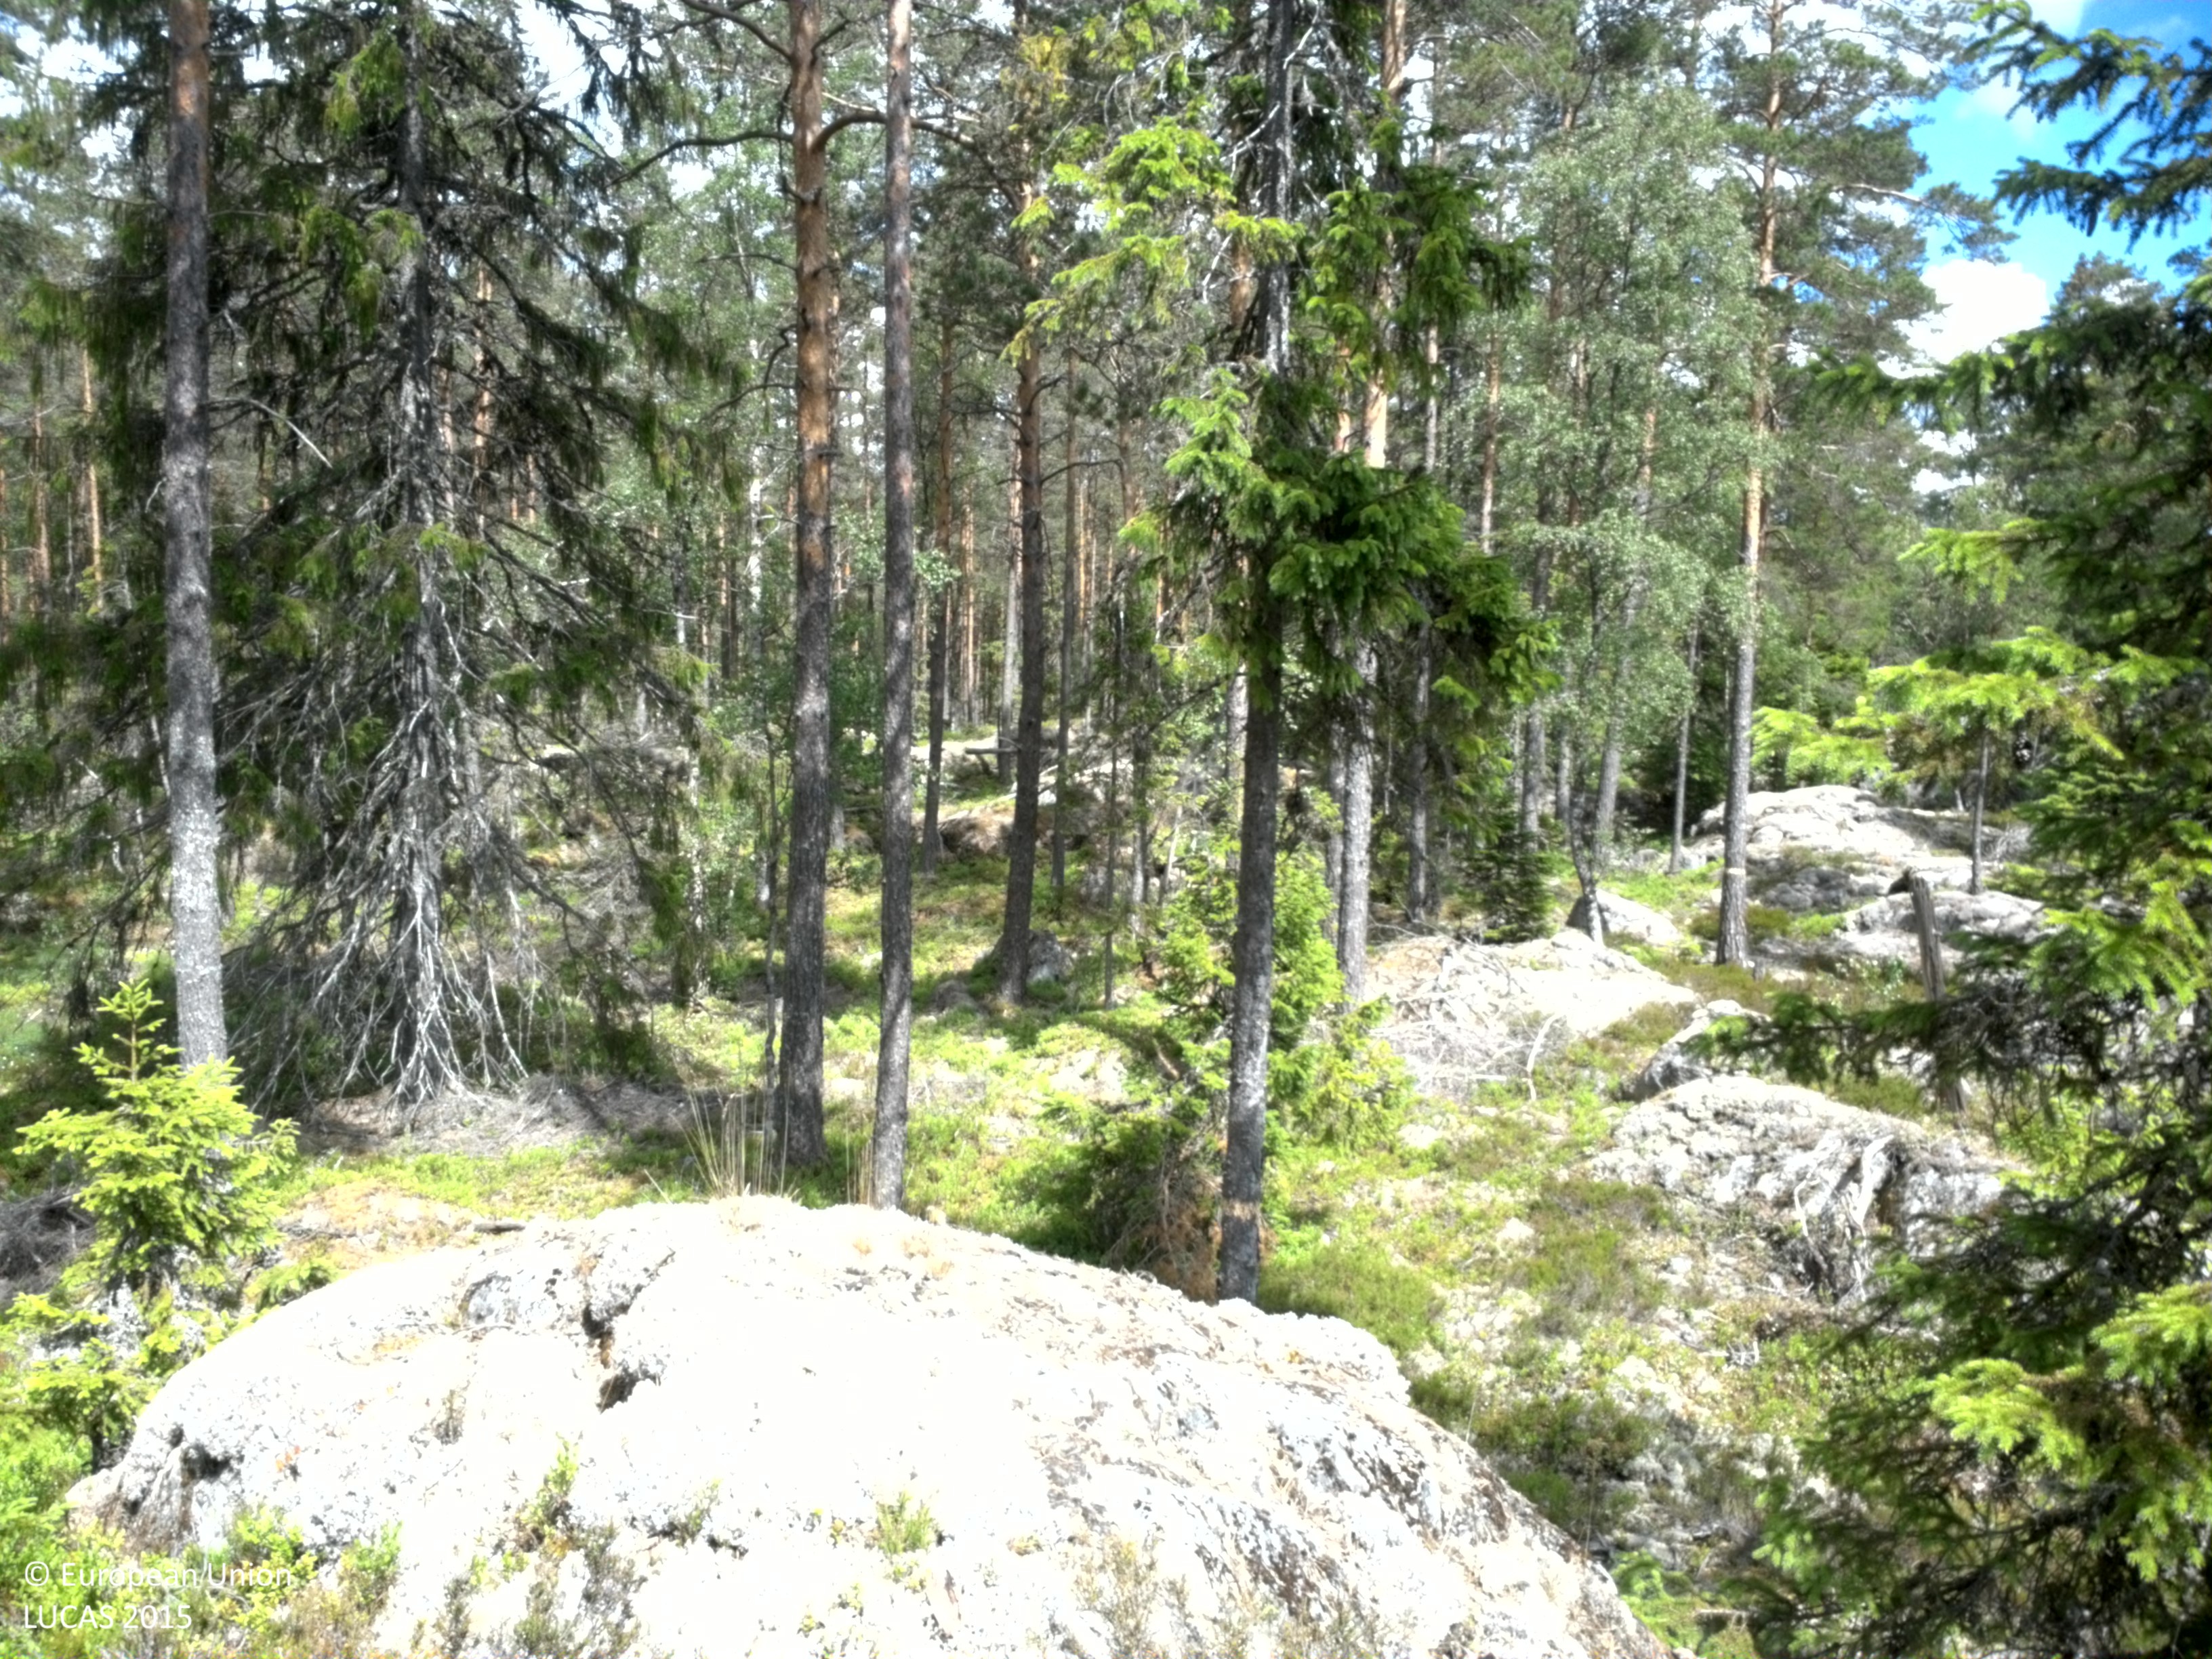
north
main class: Woodland
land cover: Pine dominated mixed woodland
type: boreal forest
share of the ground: 25 - 50 %
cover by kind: coniferous forest trees 30 %, herbaceous plants 30 %, lichens and mosses 25 %, broadleaved forest trees 10 %, consolidated bare surface 5 %
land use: Forestry
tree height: > 5 m
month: June
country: SE
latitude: 59.9655
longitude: 17.1030
